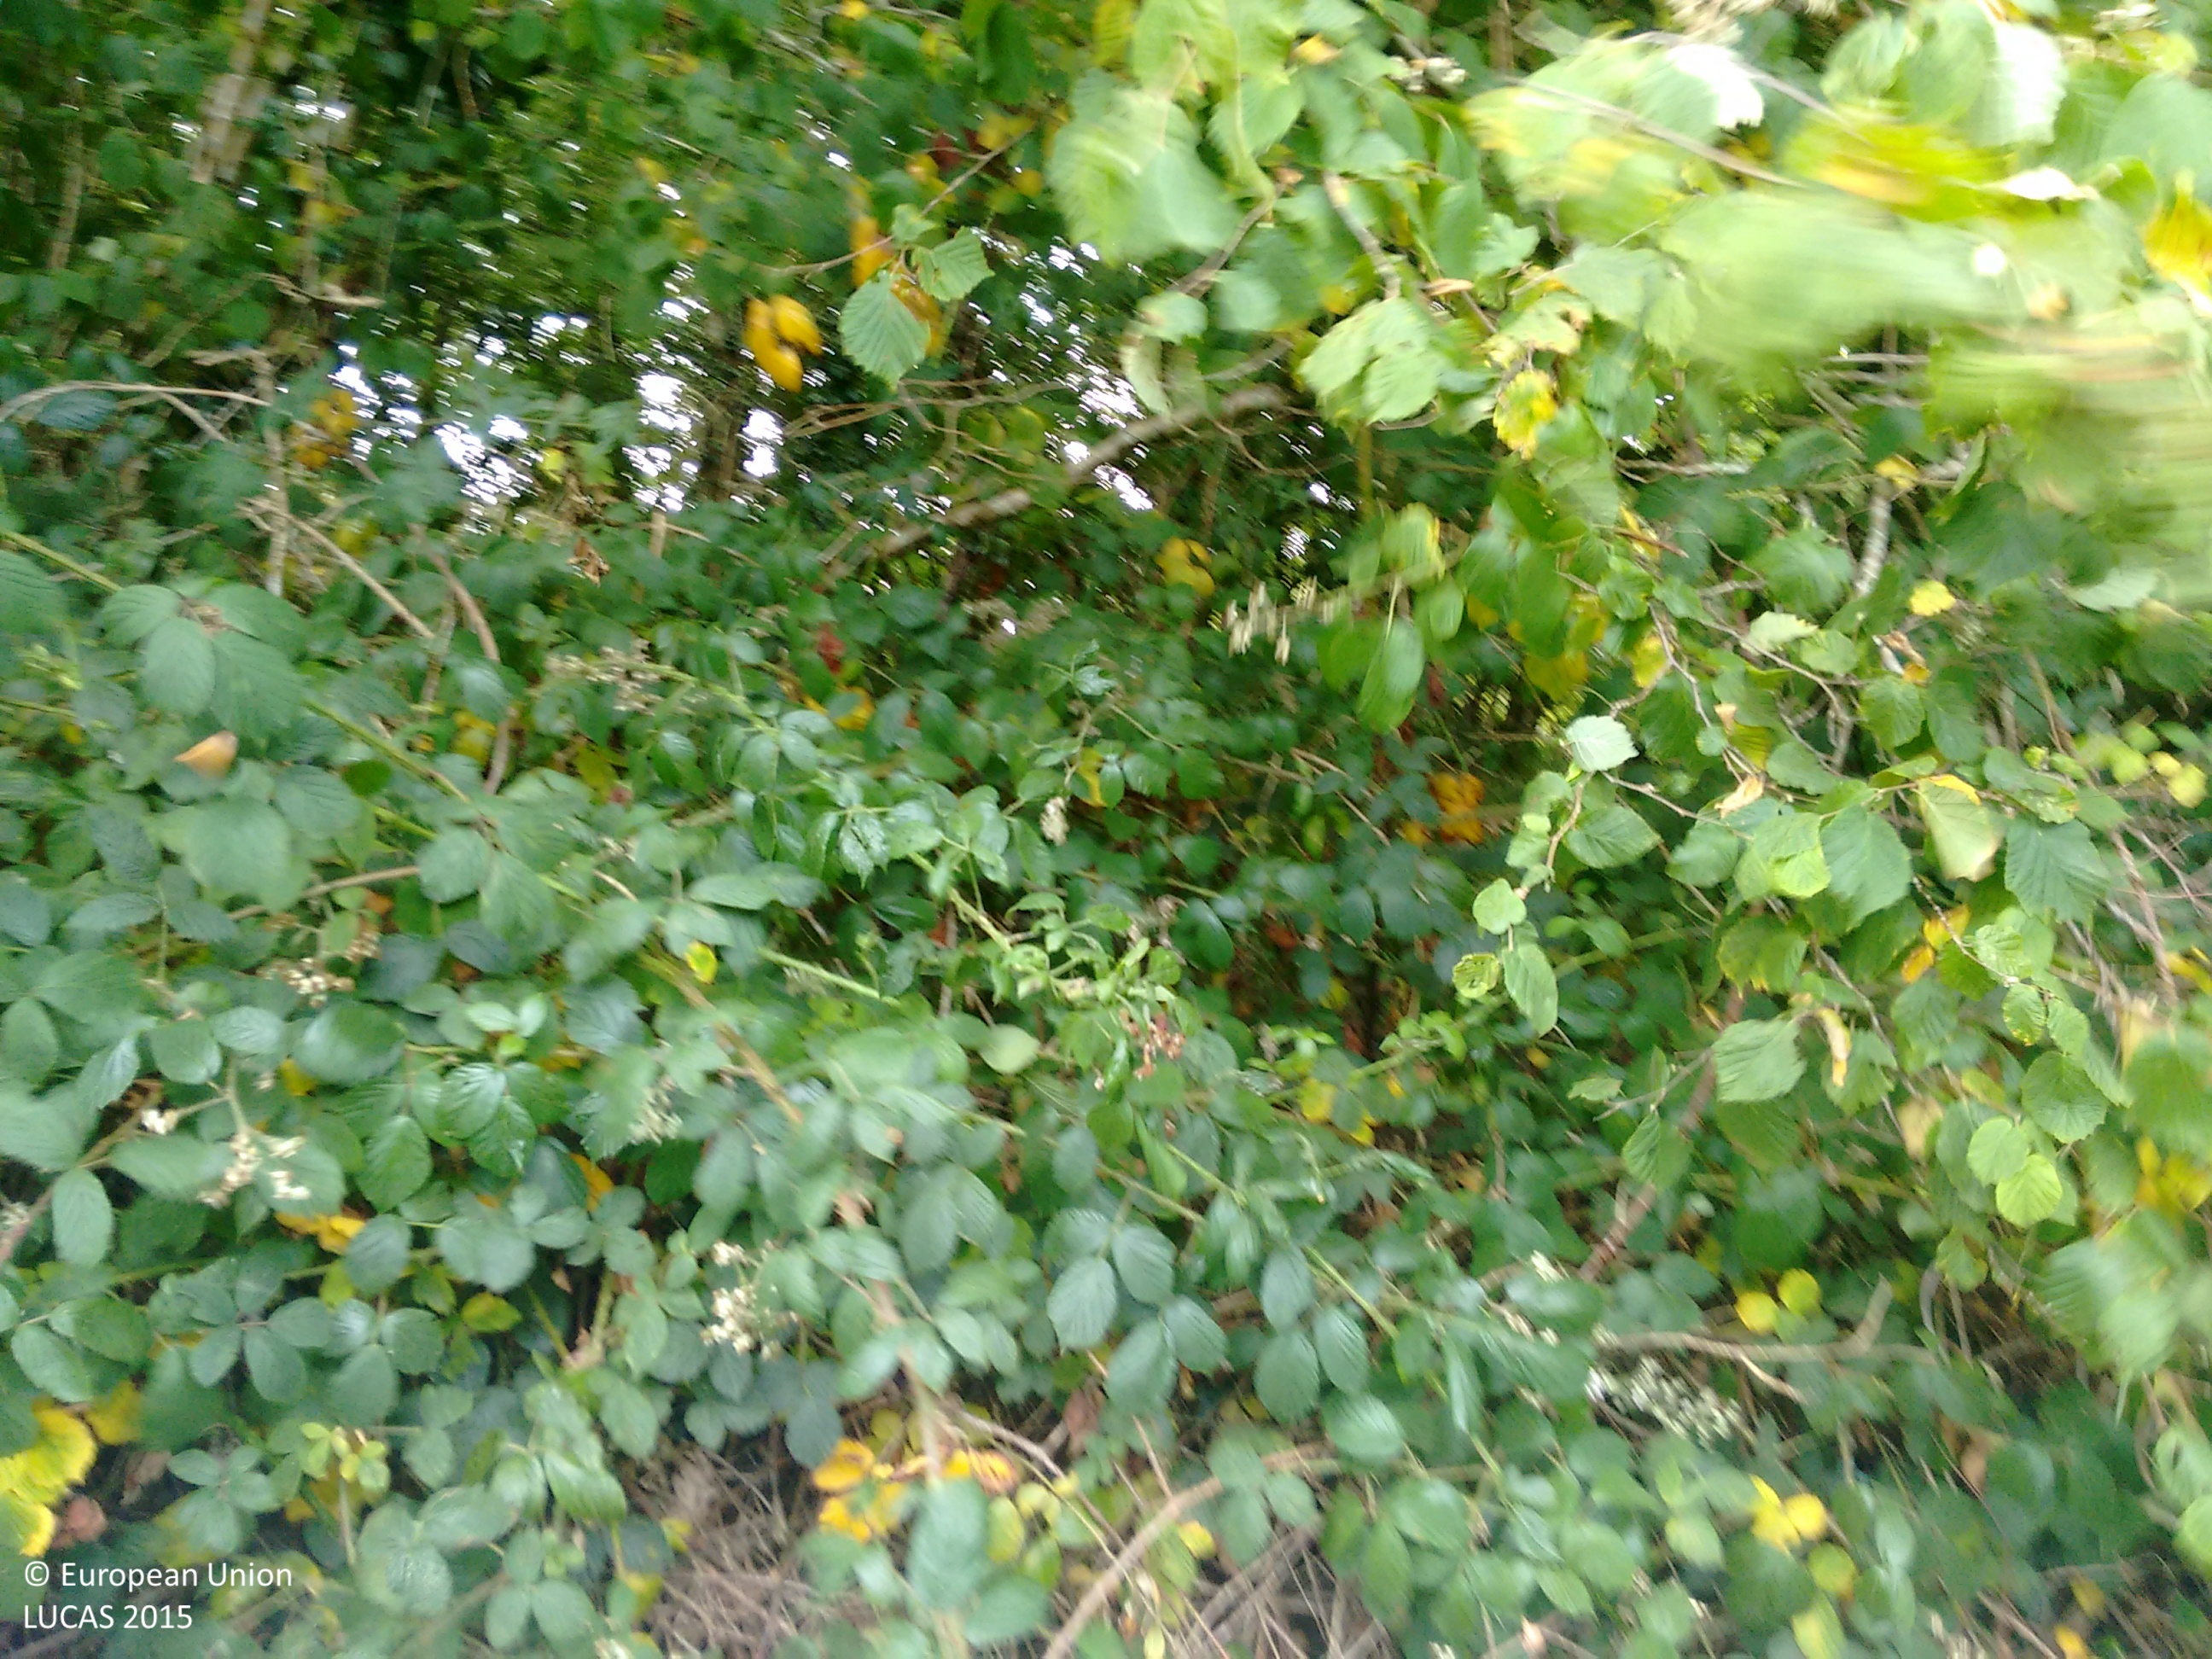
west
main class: Woodland
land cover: Broadleaved woodland
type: mesophytic deciduous forest
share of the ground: > 75 %
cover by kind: broadleaved forest trees 75 %
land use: Semi-natural and natural areas not in use
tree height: > 5 m
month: September
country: IE
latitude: 52.0496
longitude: -9.4044
